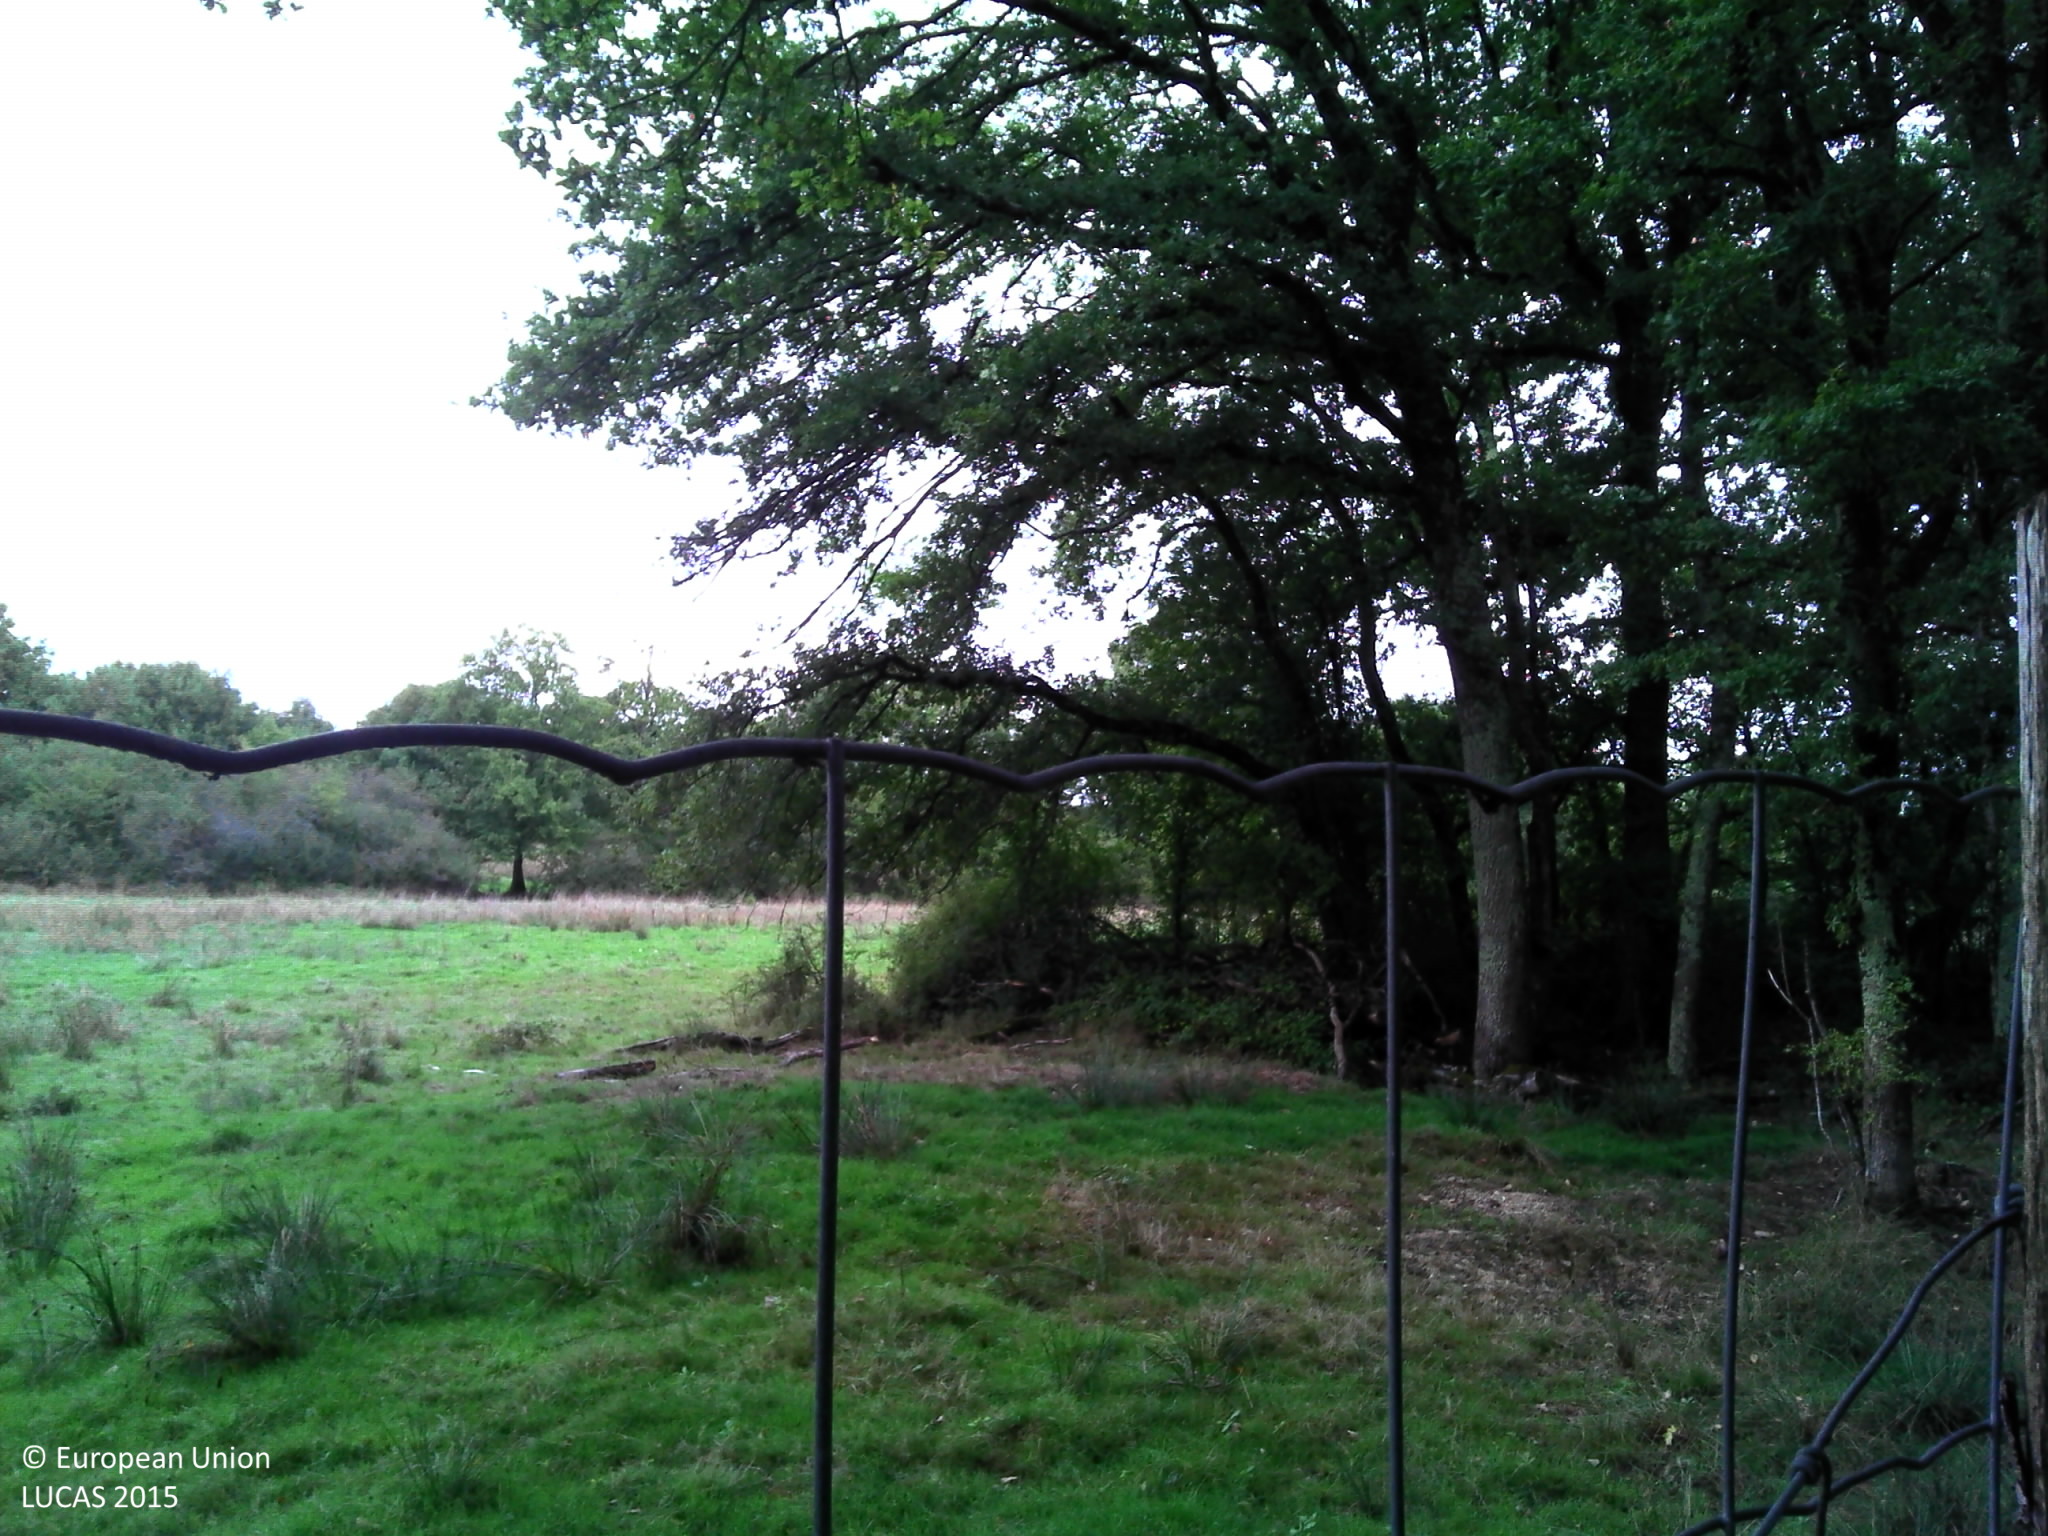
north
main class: Grassland
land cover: Grassland without tree/shrub cover
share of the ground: > 75 %
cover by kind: herbaceous plants 100 %
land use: Agriculture (excluding fallow land and kitchen gardens)
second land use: Amenities, museums, leisure
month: September
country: FR
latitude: 46.4924
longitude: 1.1673
